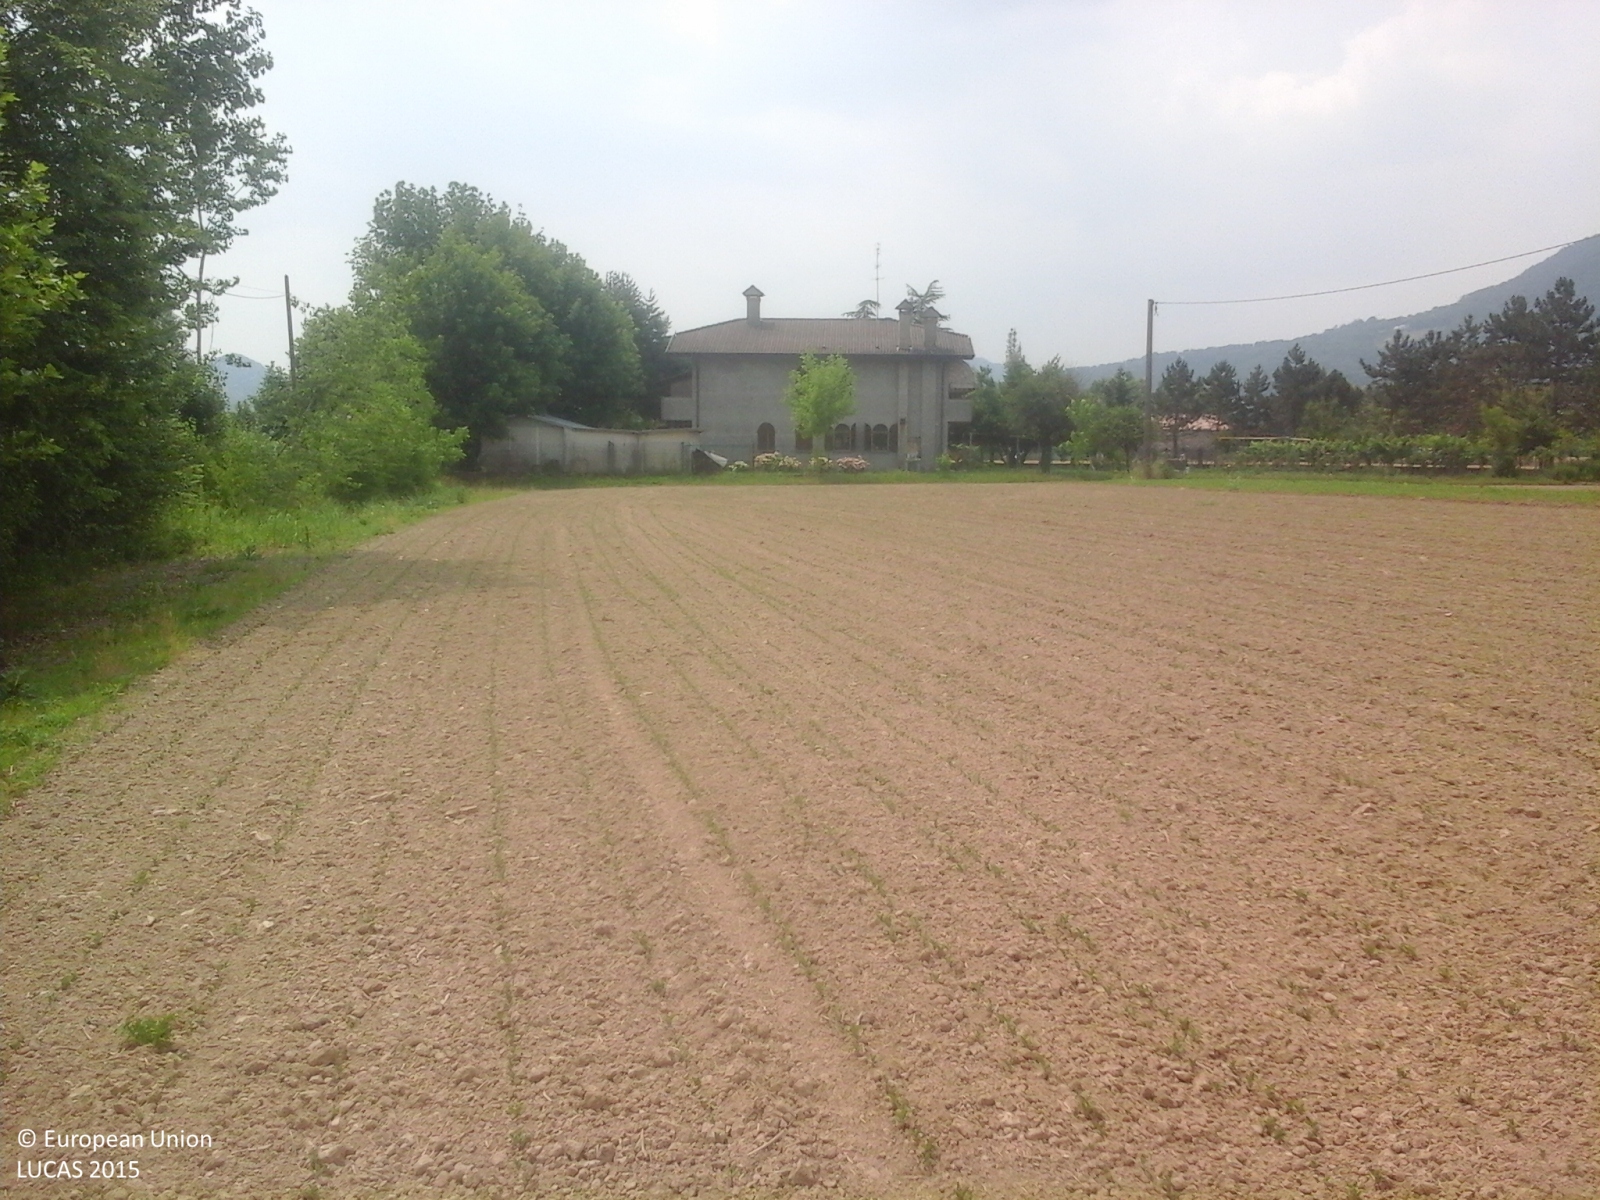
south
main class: Cropland
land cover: Soya
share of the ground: < 10 %
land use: Agriculture (excluding fallow land and kitchen gardens)
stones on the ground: < 10 %
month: June
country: IT
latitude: 45.3826
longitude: 11.6957
